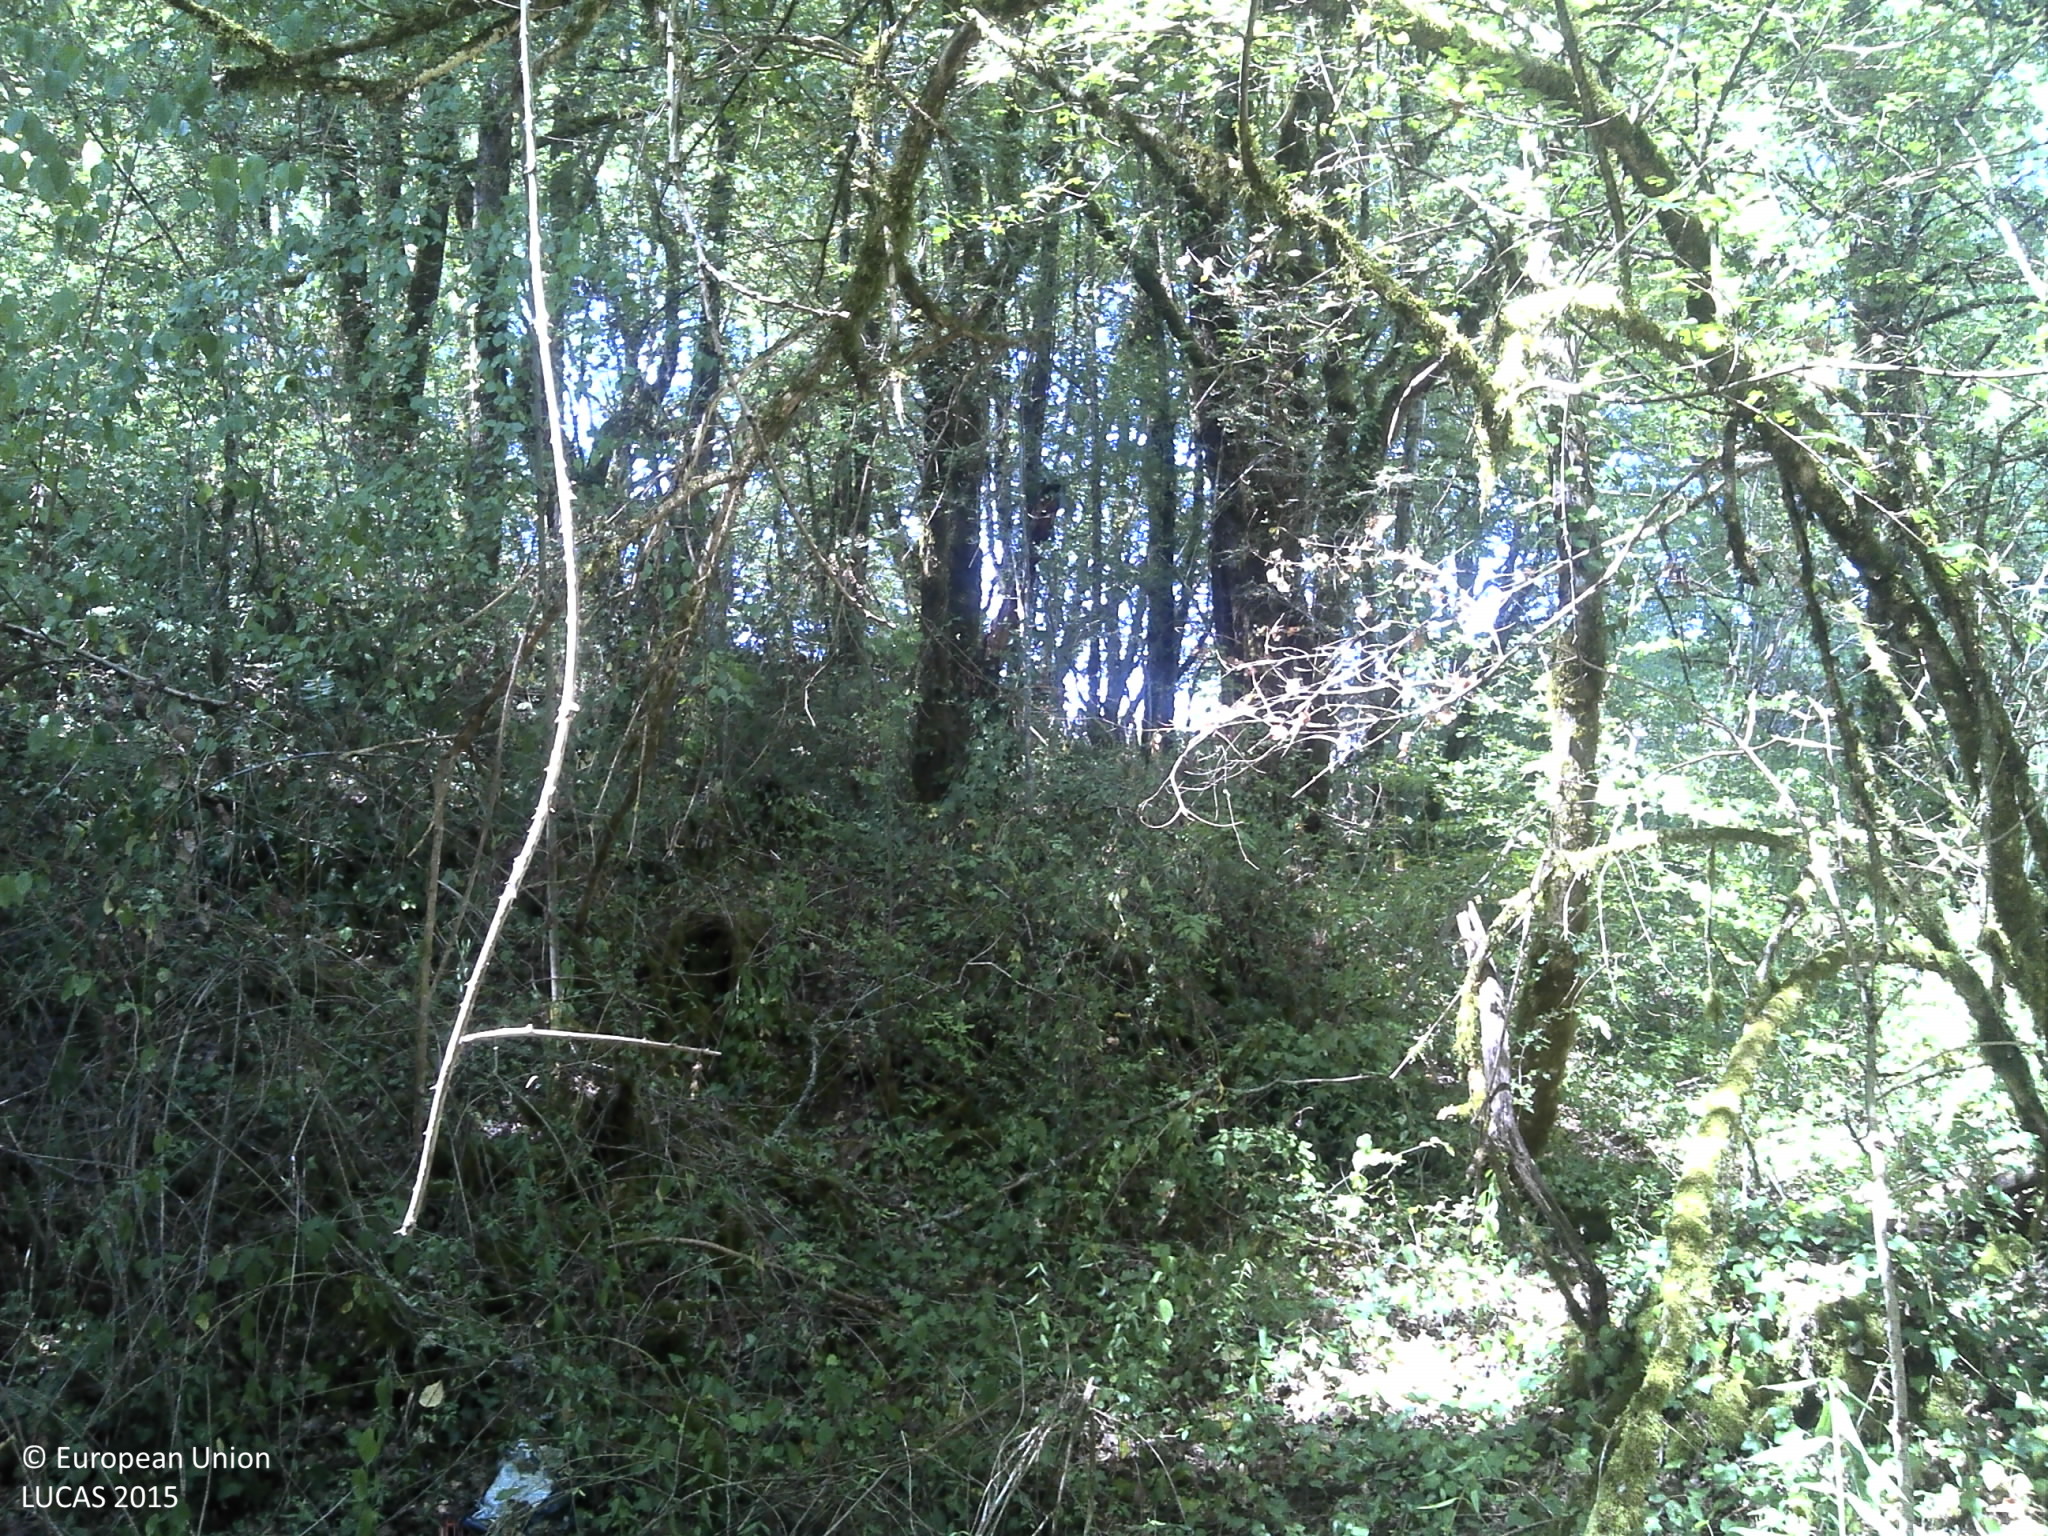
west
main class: Woodland
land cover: Broadleaved woodland
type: thermophilous deciduous forest
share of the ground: > 75 %
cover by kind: broadleaved forest trees 65 %, herbaceous plants 20 %, unconsolidated bare surface 5 %
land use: Abandoned areas
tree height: > 5 m
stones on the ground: < 10 %
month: July
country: FR
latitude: 45.0528
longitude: 1.7307
